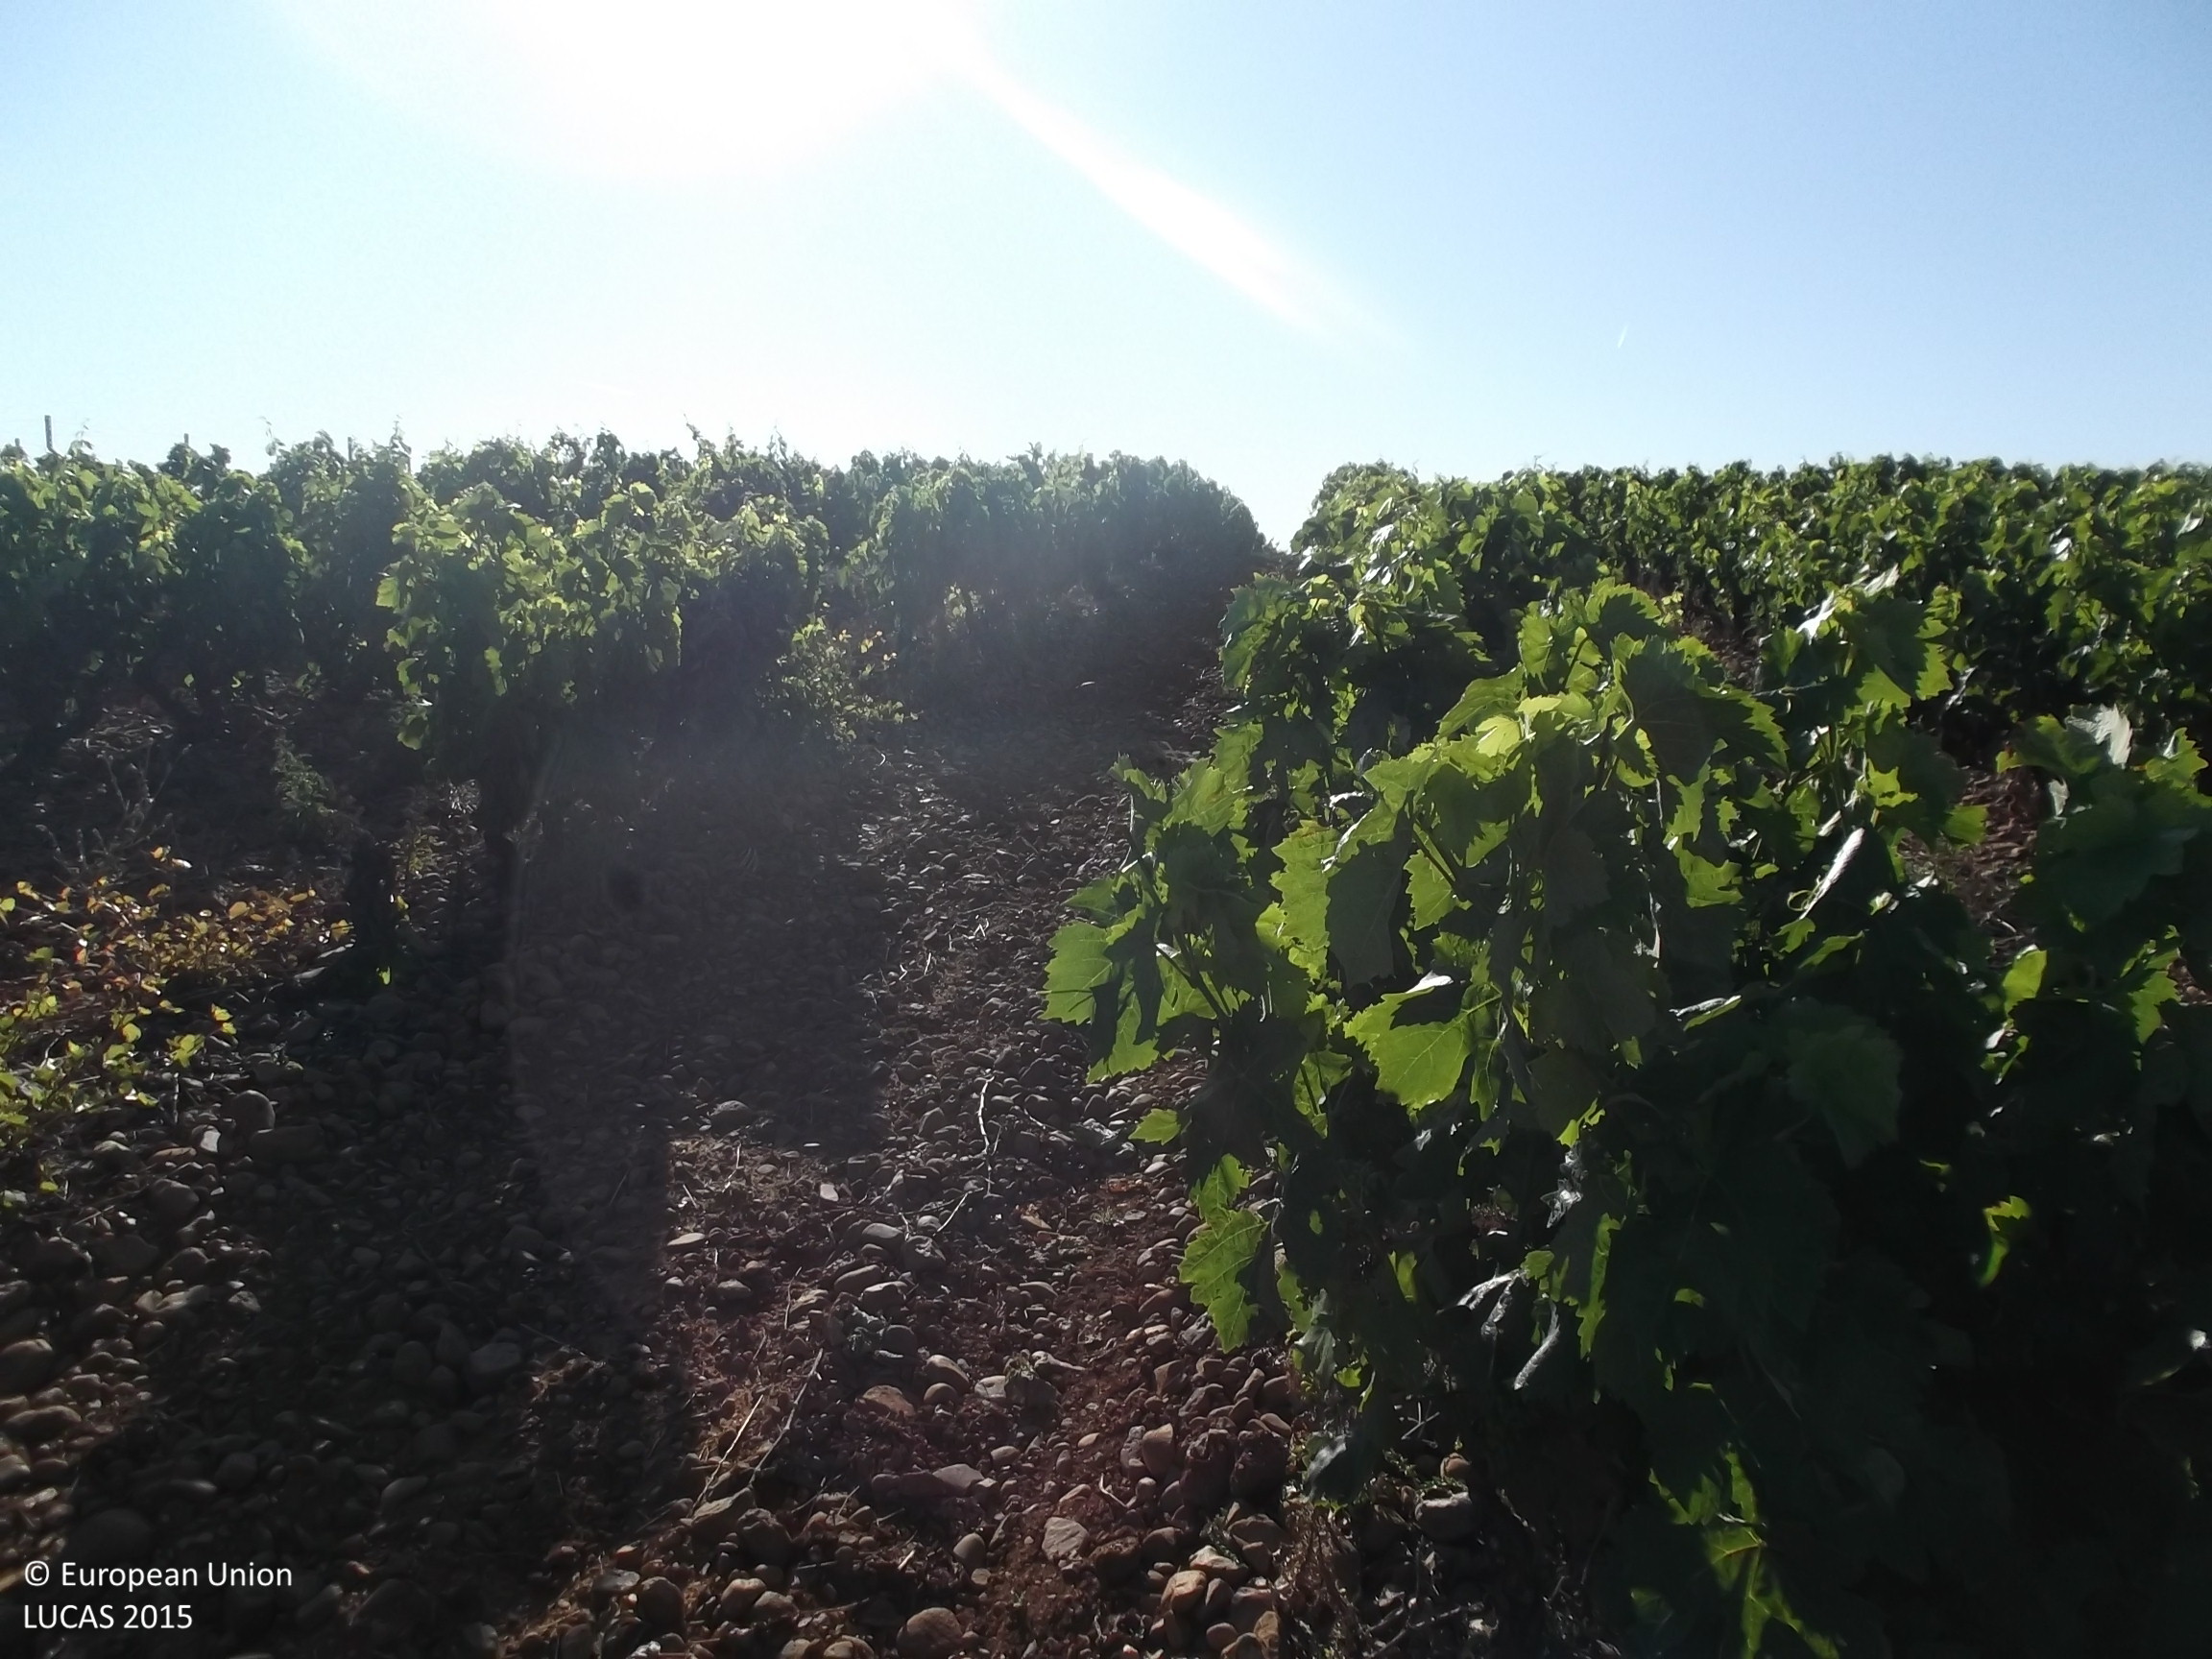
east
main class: Cropland
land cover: Vineyards
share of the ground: 10 - 25 %
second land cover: Other bare soil
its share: > 75 %
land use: Agriculture (excluding fallow land and kitchen gardens)
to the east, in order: Vineyards; Other bare soil; Tracks; Vineyards
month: June
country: ES
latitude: 42.3225
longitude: -2.1377
